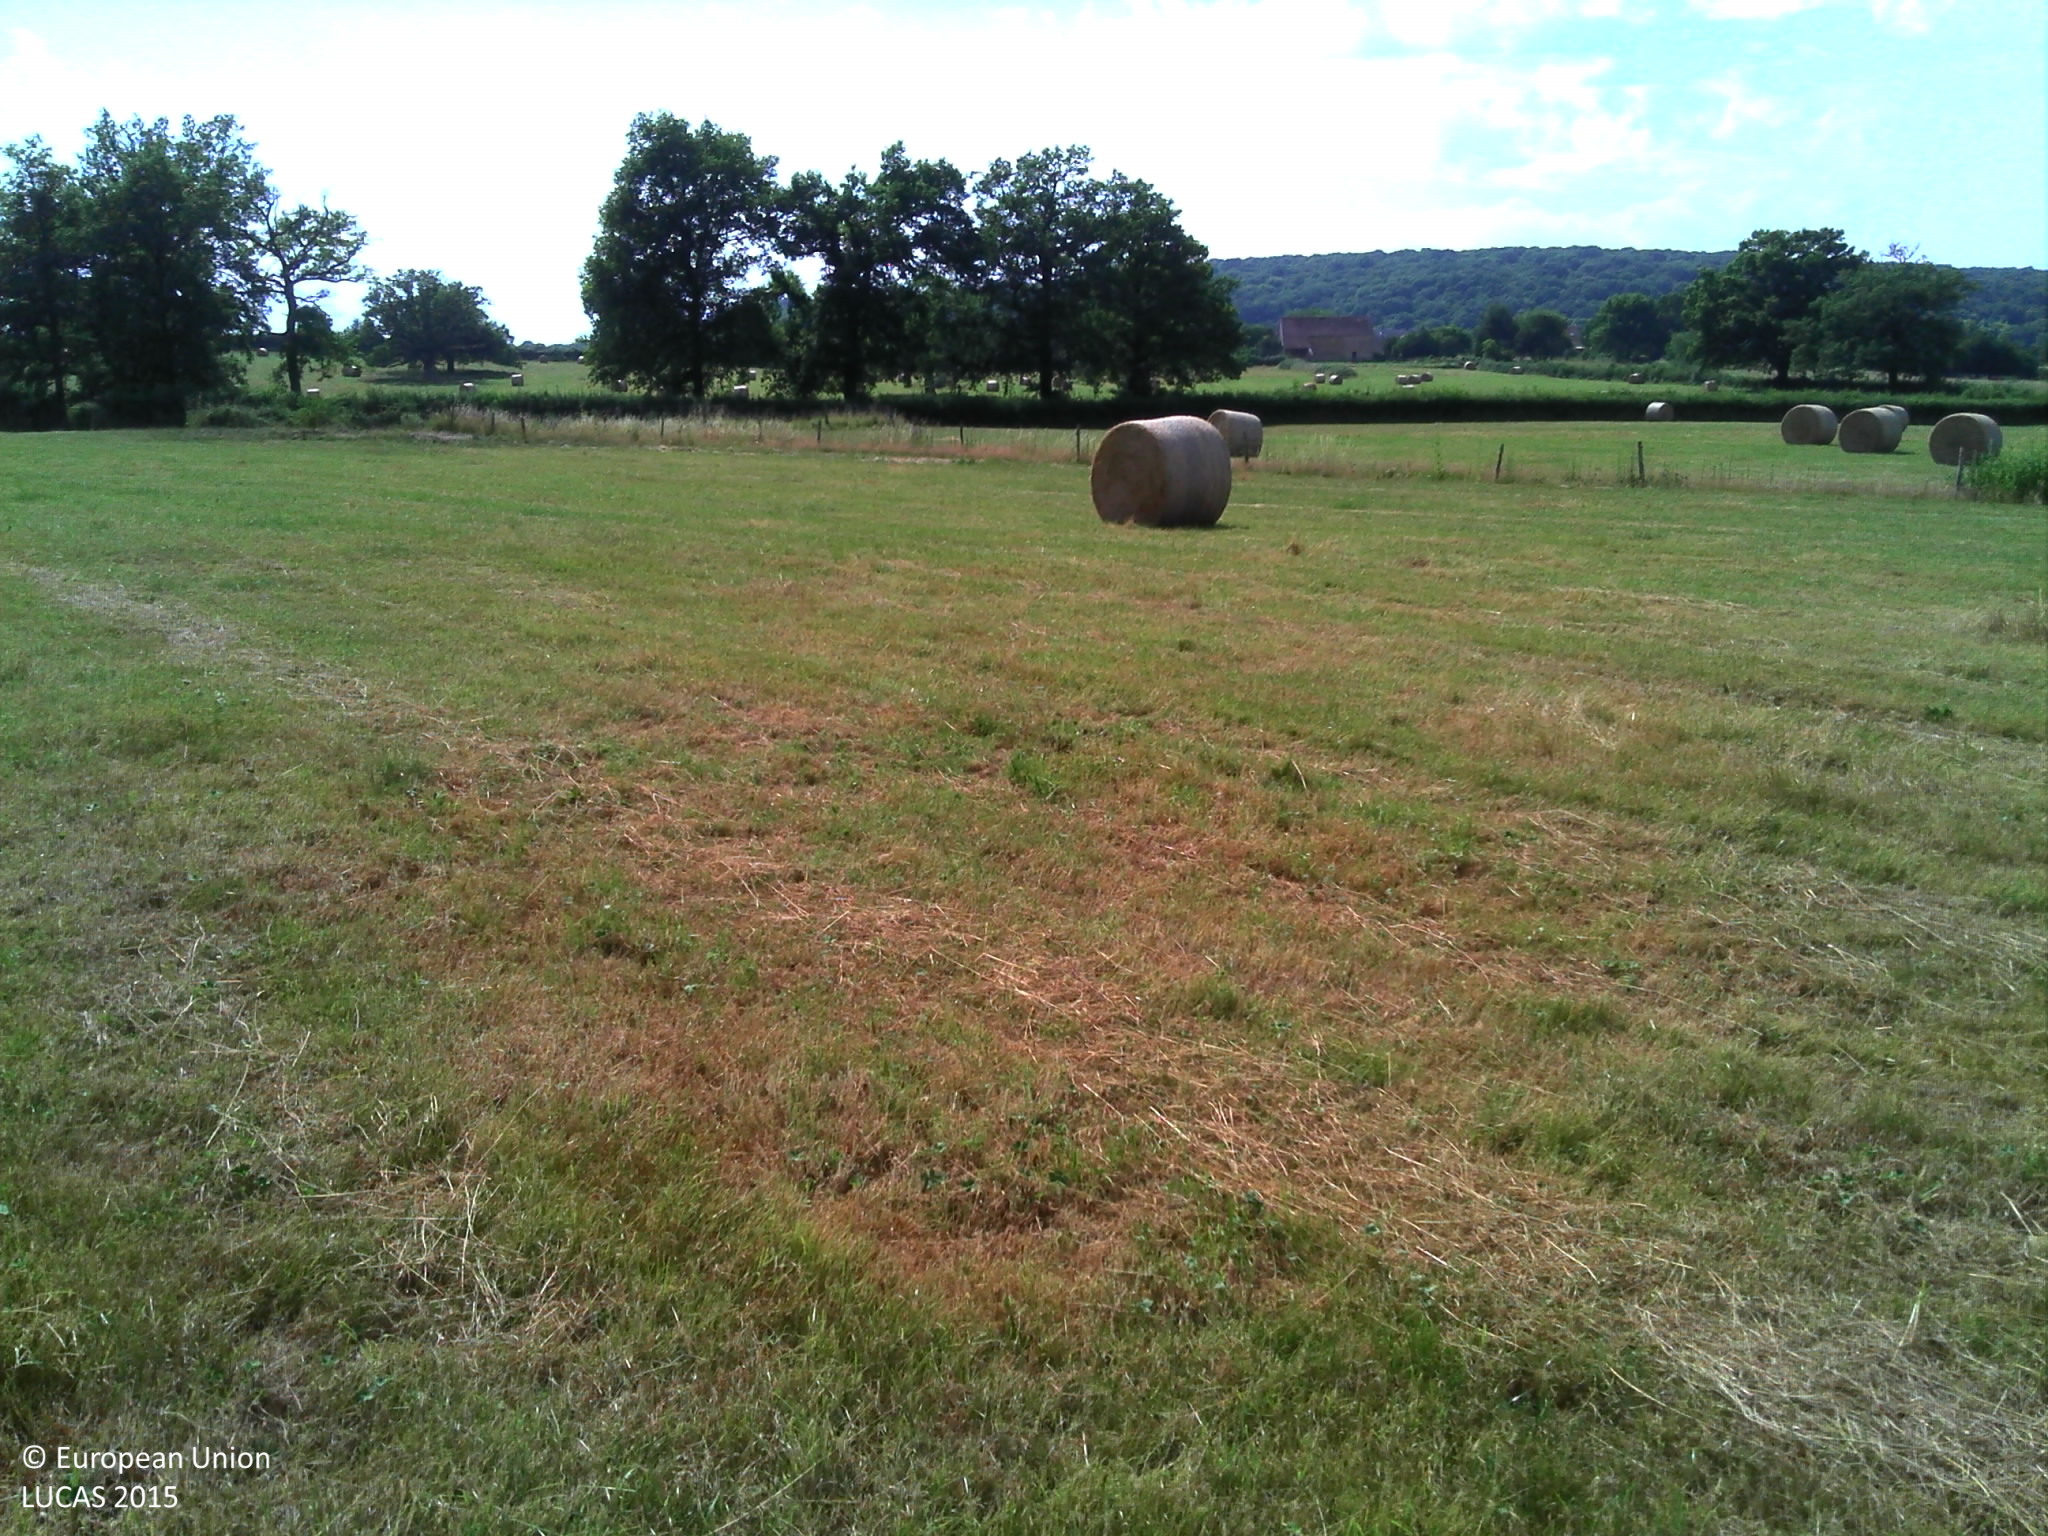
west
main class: Grassland
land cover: Grassland without tree/shrub cover
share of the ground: > 75 %
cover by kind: herbaceous plants 100 %
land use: Agriculture (excluding fallow land and kitchen gardens)
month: July
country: FR
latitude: 47.2379
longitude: 3.5109
